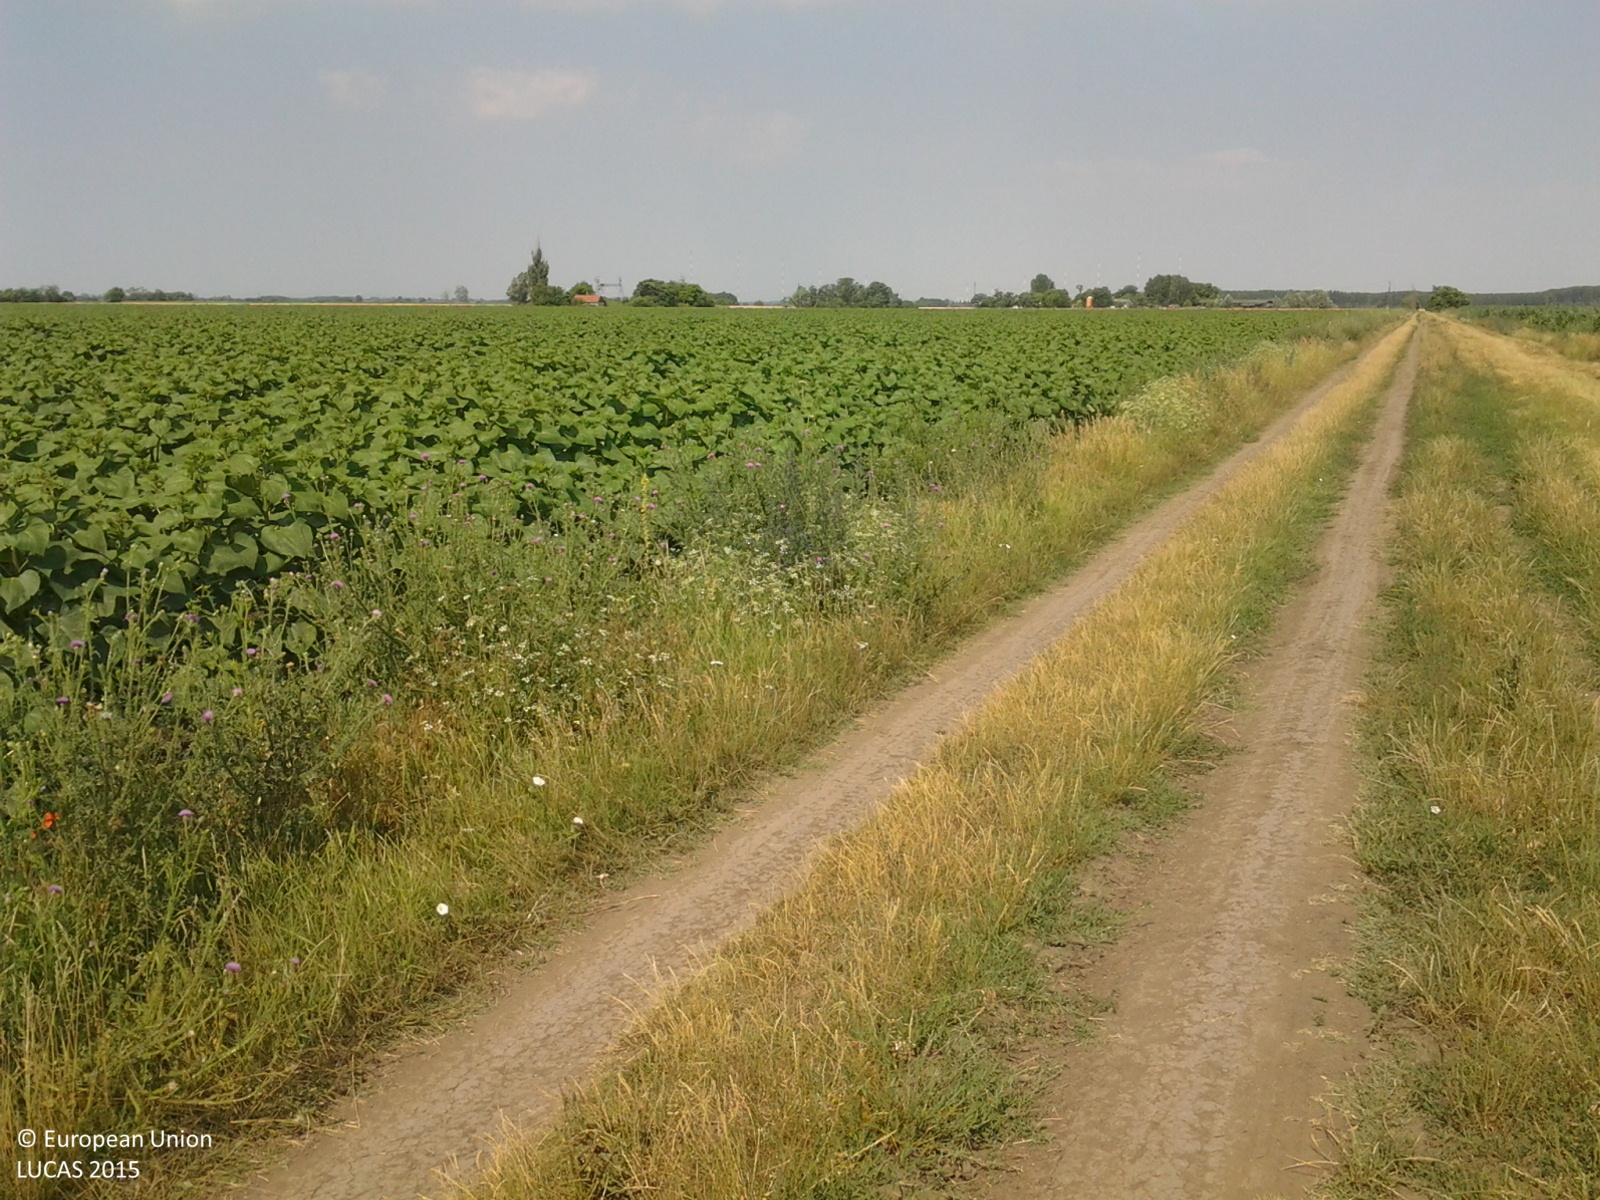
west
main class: Grassland
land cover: Grassland without tree/shrub cover
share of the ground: > 75 %
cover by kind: herbaceous plants 100 %
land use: Agriculture (excluding fallow land and kitchen gardens)
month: July
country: HU
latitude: 47.5593
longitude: 19.8999
